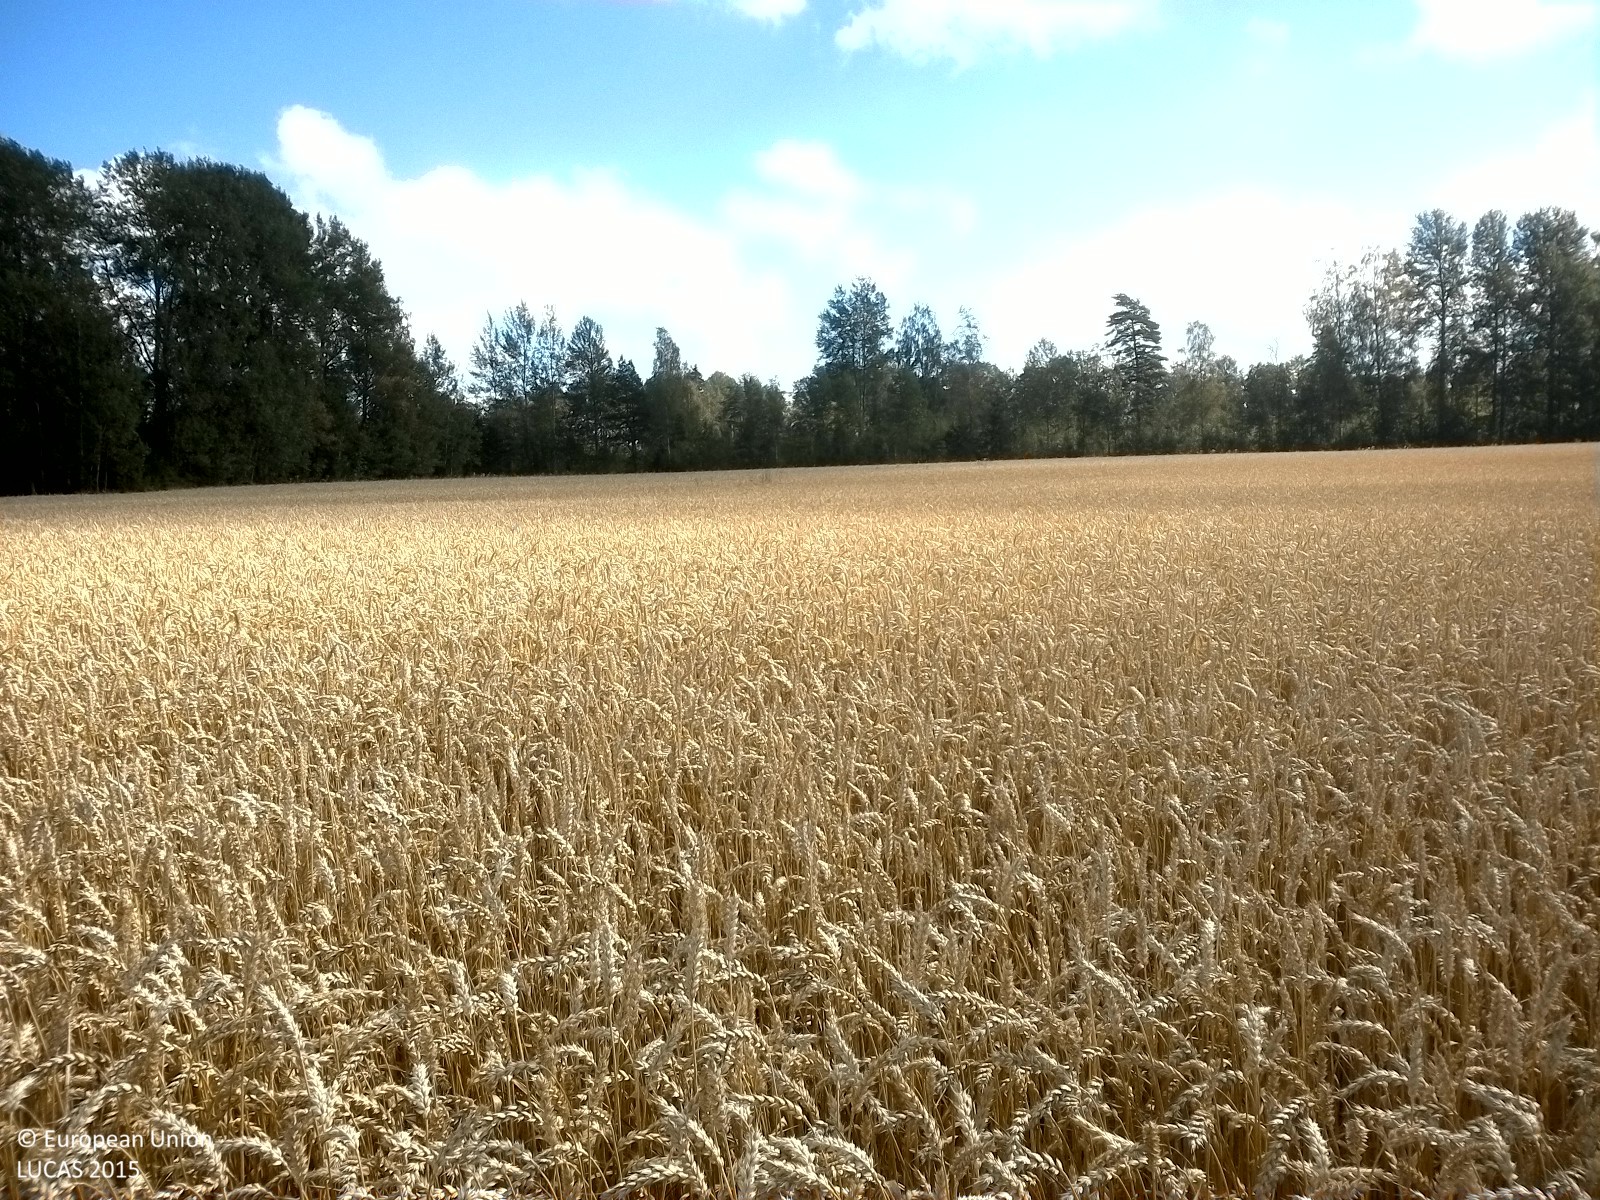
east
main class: Cropland
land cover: Common wheat
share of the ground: > 75 %
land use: Agriculture (excluding fallow land and kitchen gardens)
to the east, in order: Common wheat; Ditches and canals; Broadleaved woodland; Electric lines; Broadleaved woodland
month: August
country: SE
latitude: 59.4370
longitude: 15.1571
